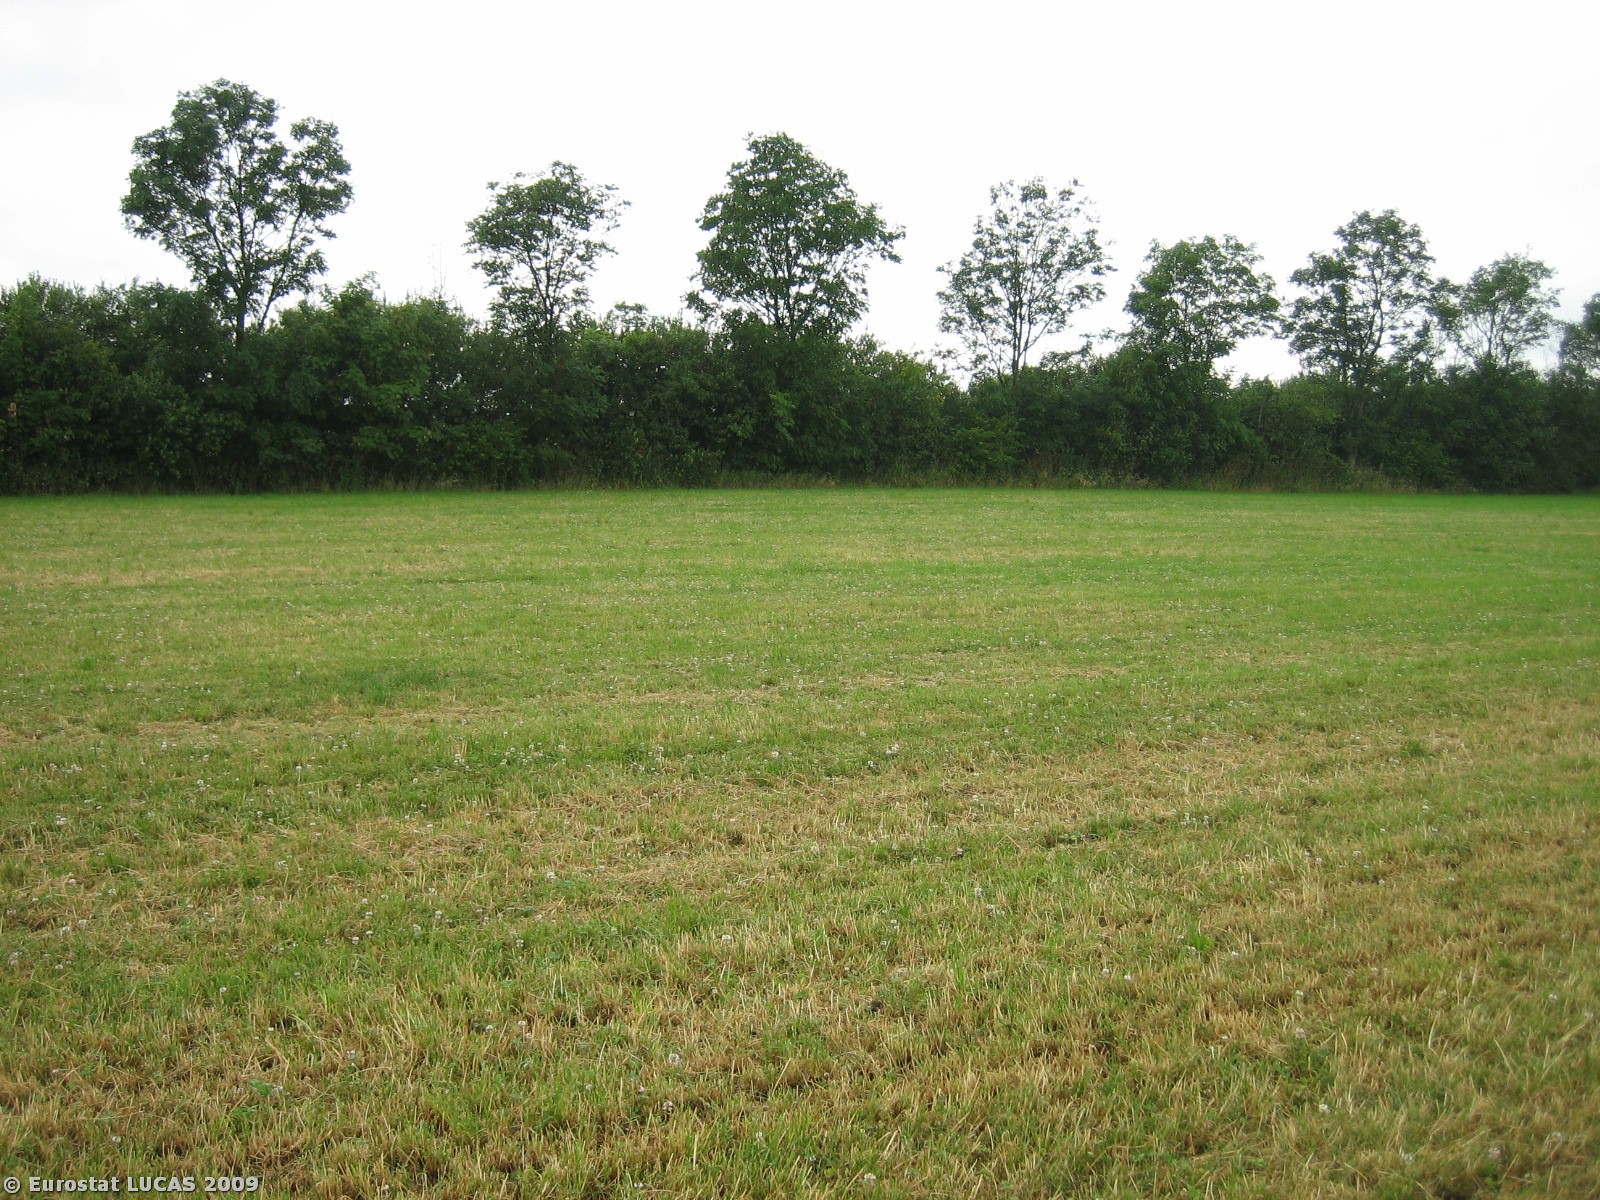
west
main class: Cropland
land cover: Temporary grasslands
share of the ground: > 75 %
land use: Agriculture (excluding fallow land and kitchen gardens)
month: July
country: DK
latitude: 55.4437
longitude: 8.6575
